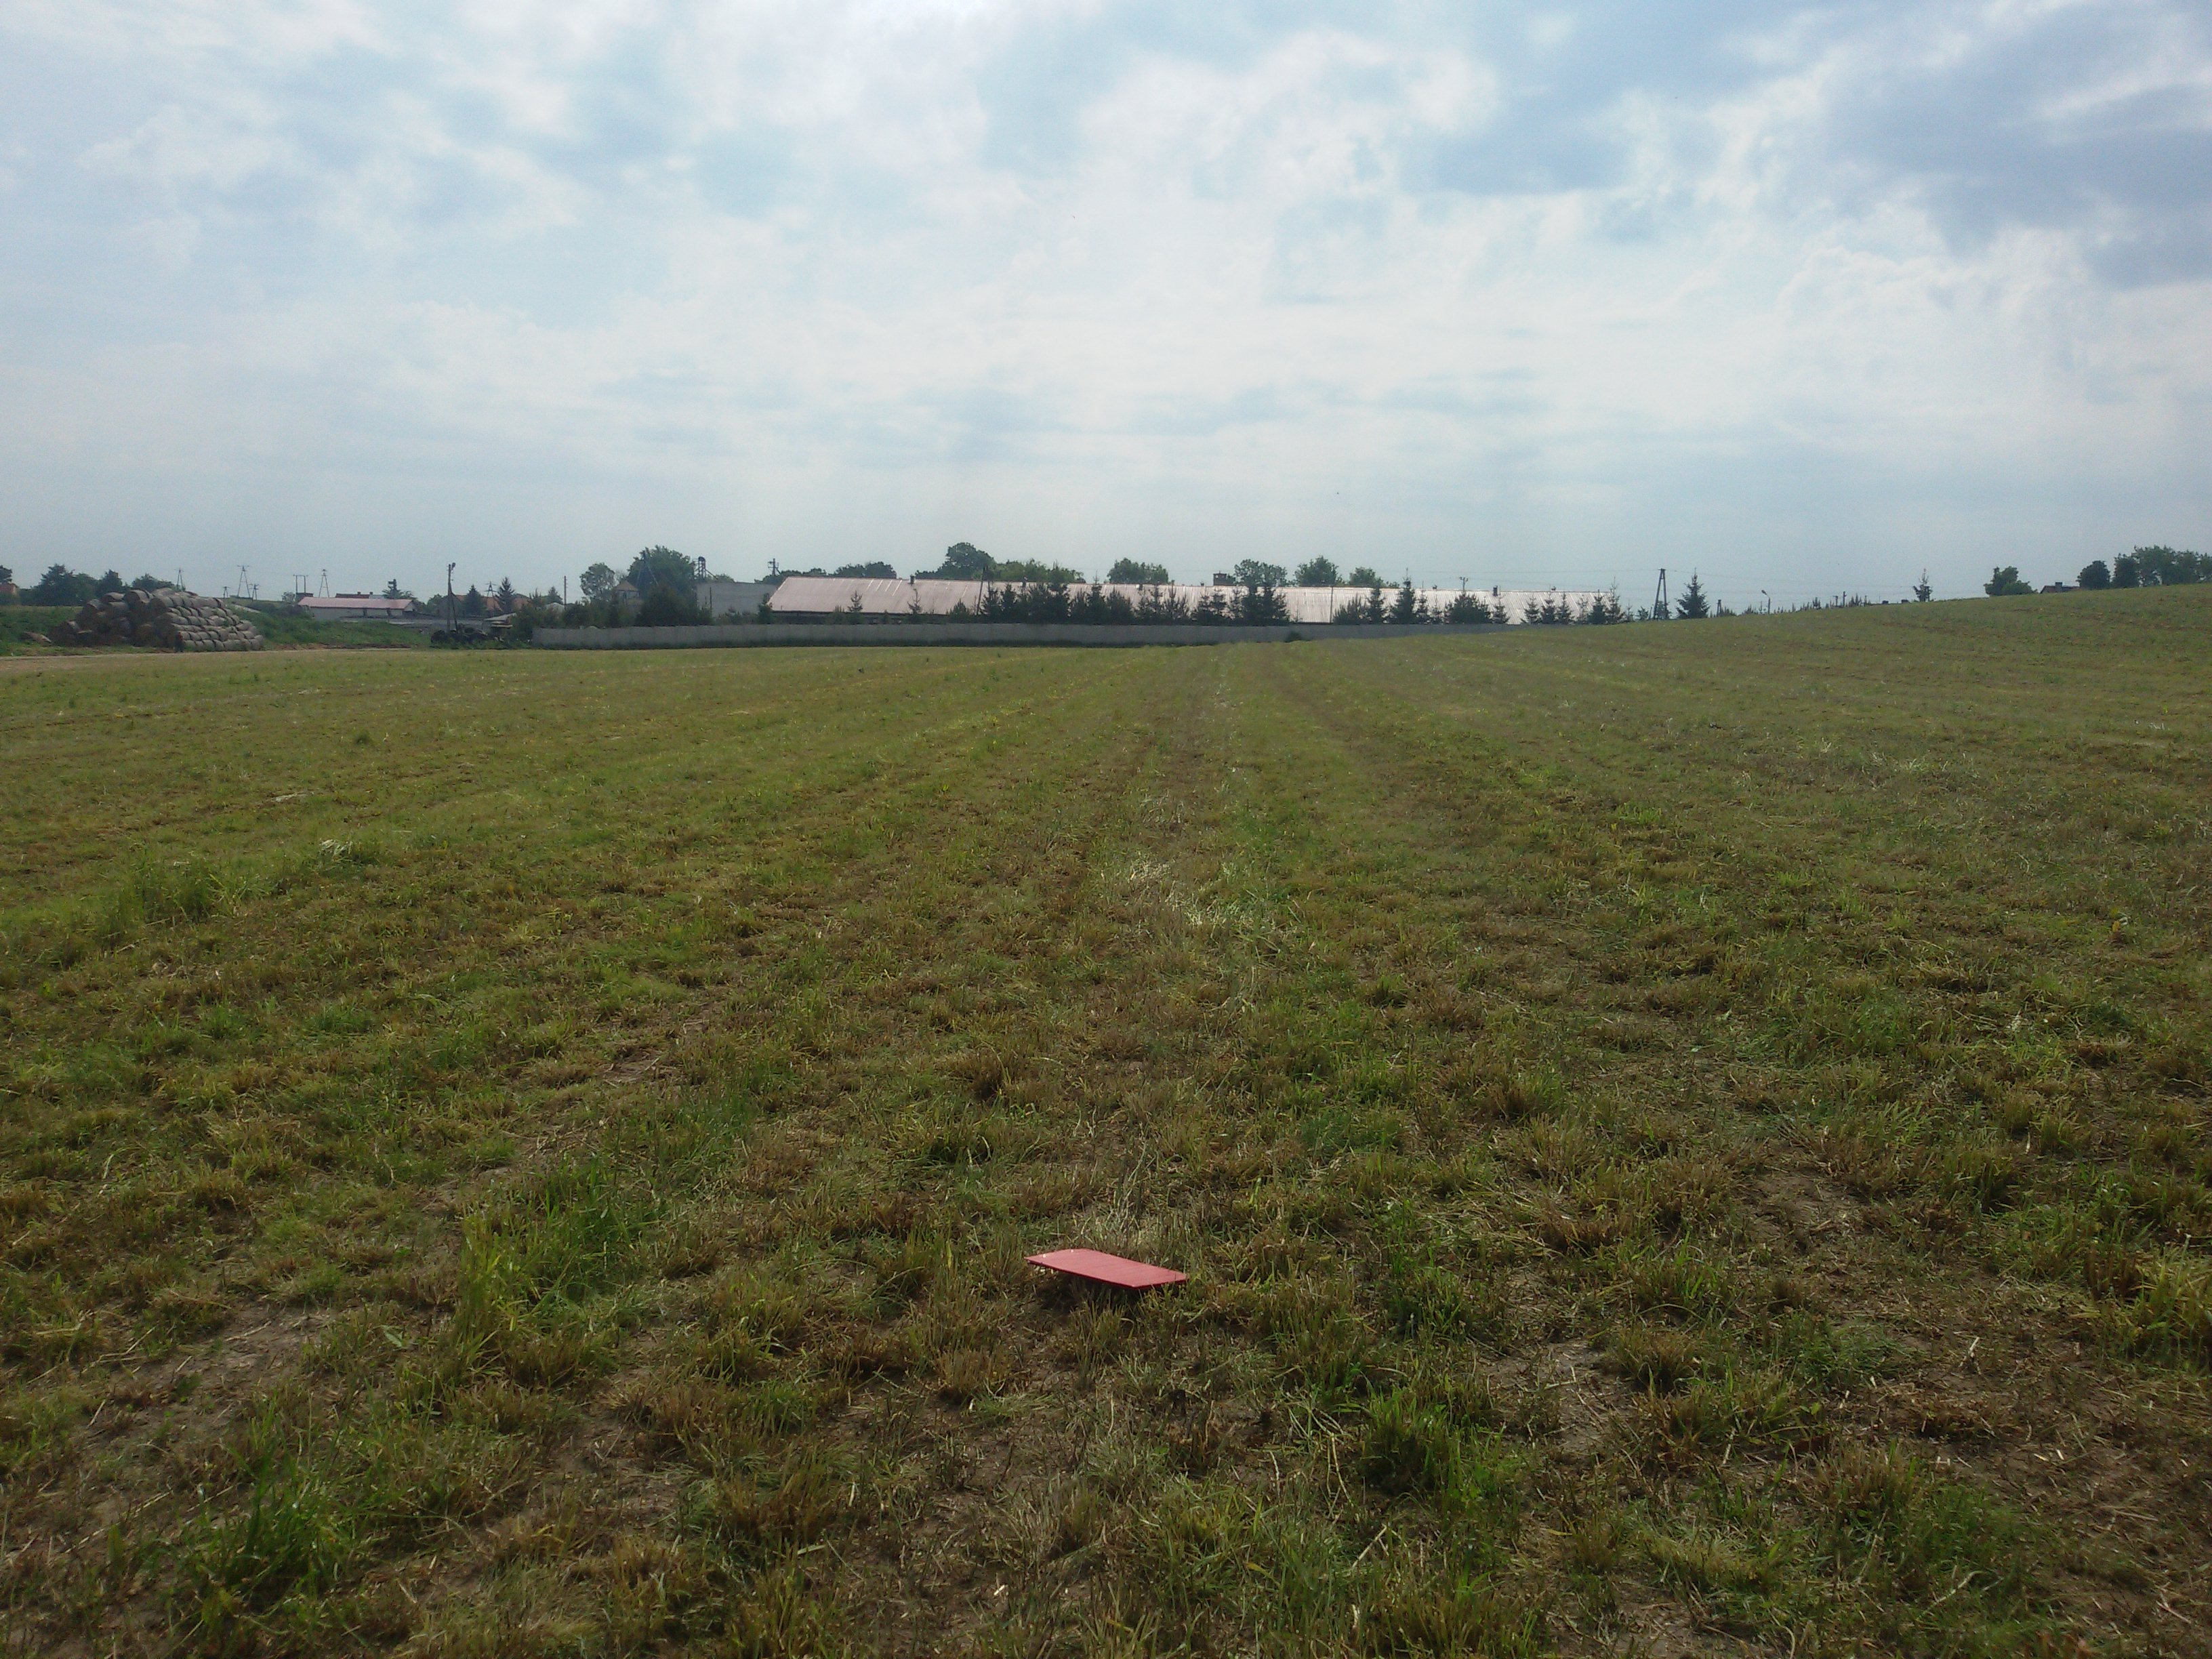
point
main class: Cropland
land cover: Temporary grasslands
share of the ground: > 75 %
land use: Agriculture (excluding fallow land and kitchen gardens)
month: May
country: PL
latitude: 50.4989
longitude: 17.1868
